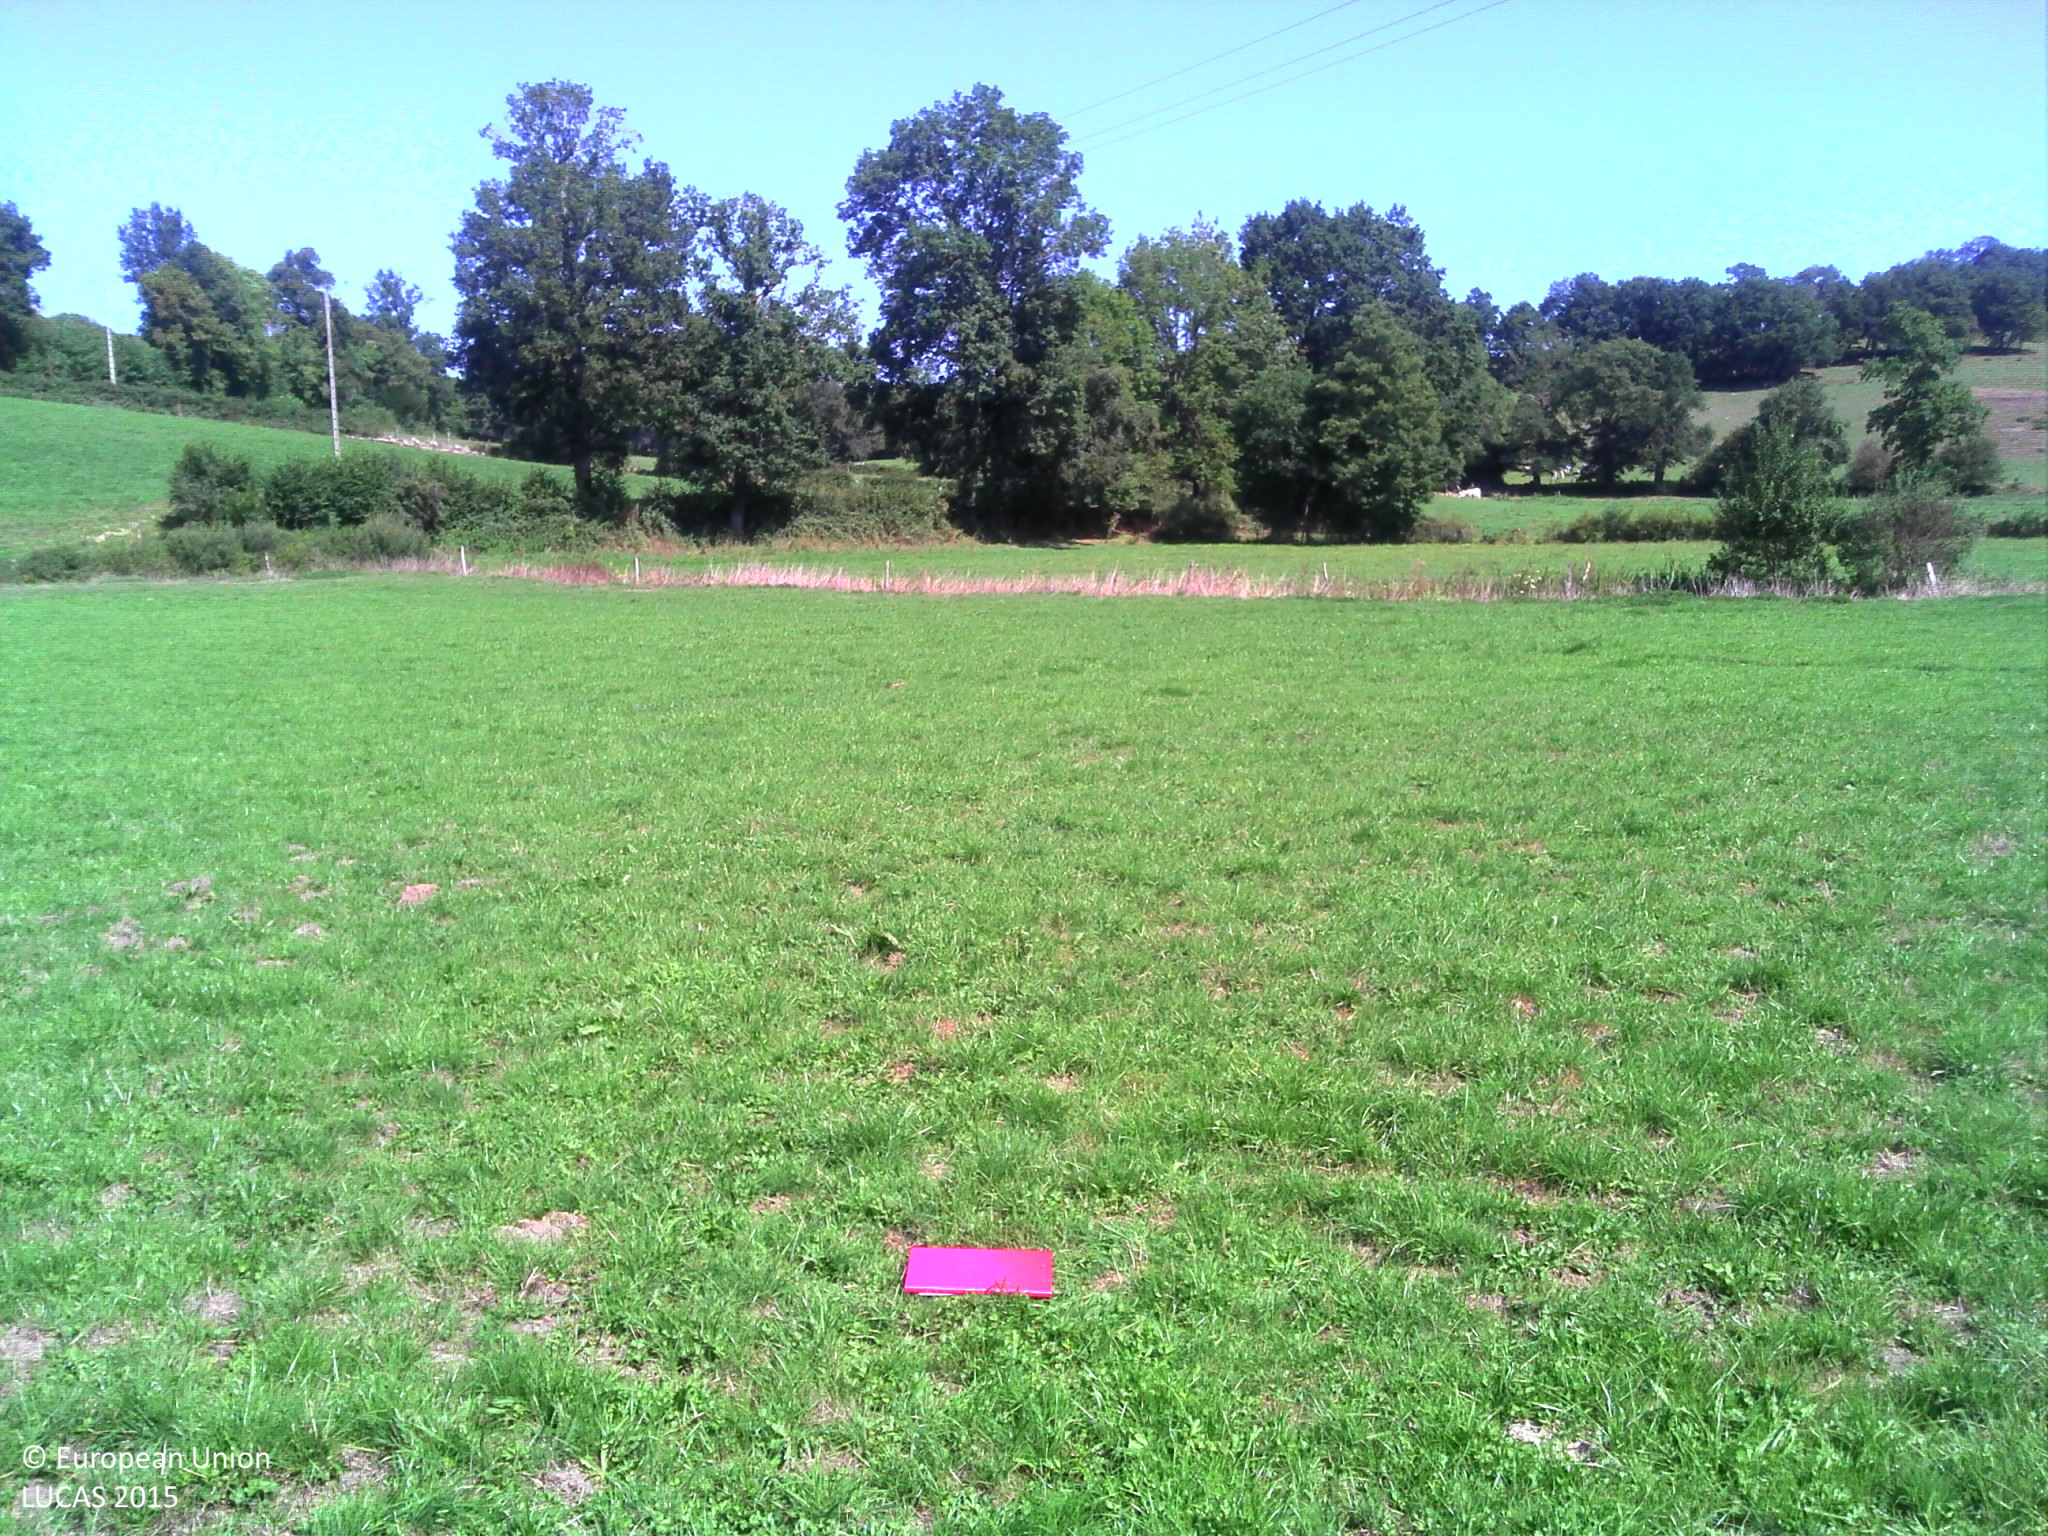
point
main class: Grassland
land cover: Grassland without tree/shrub cover
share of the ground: > 75 %
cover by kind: herbaceous plants 100 %
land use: Agriculture (excluding fallow land and kitchen gardens)
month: August
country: FR
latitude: 45.9464
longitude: 2.2947
